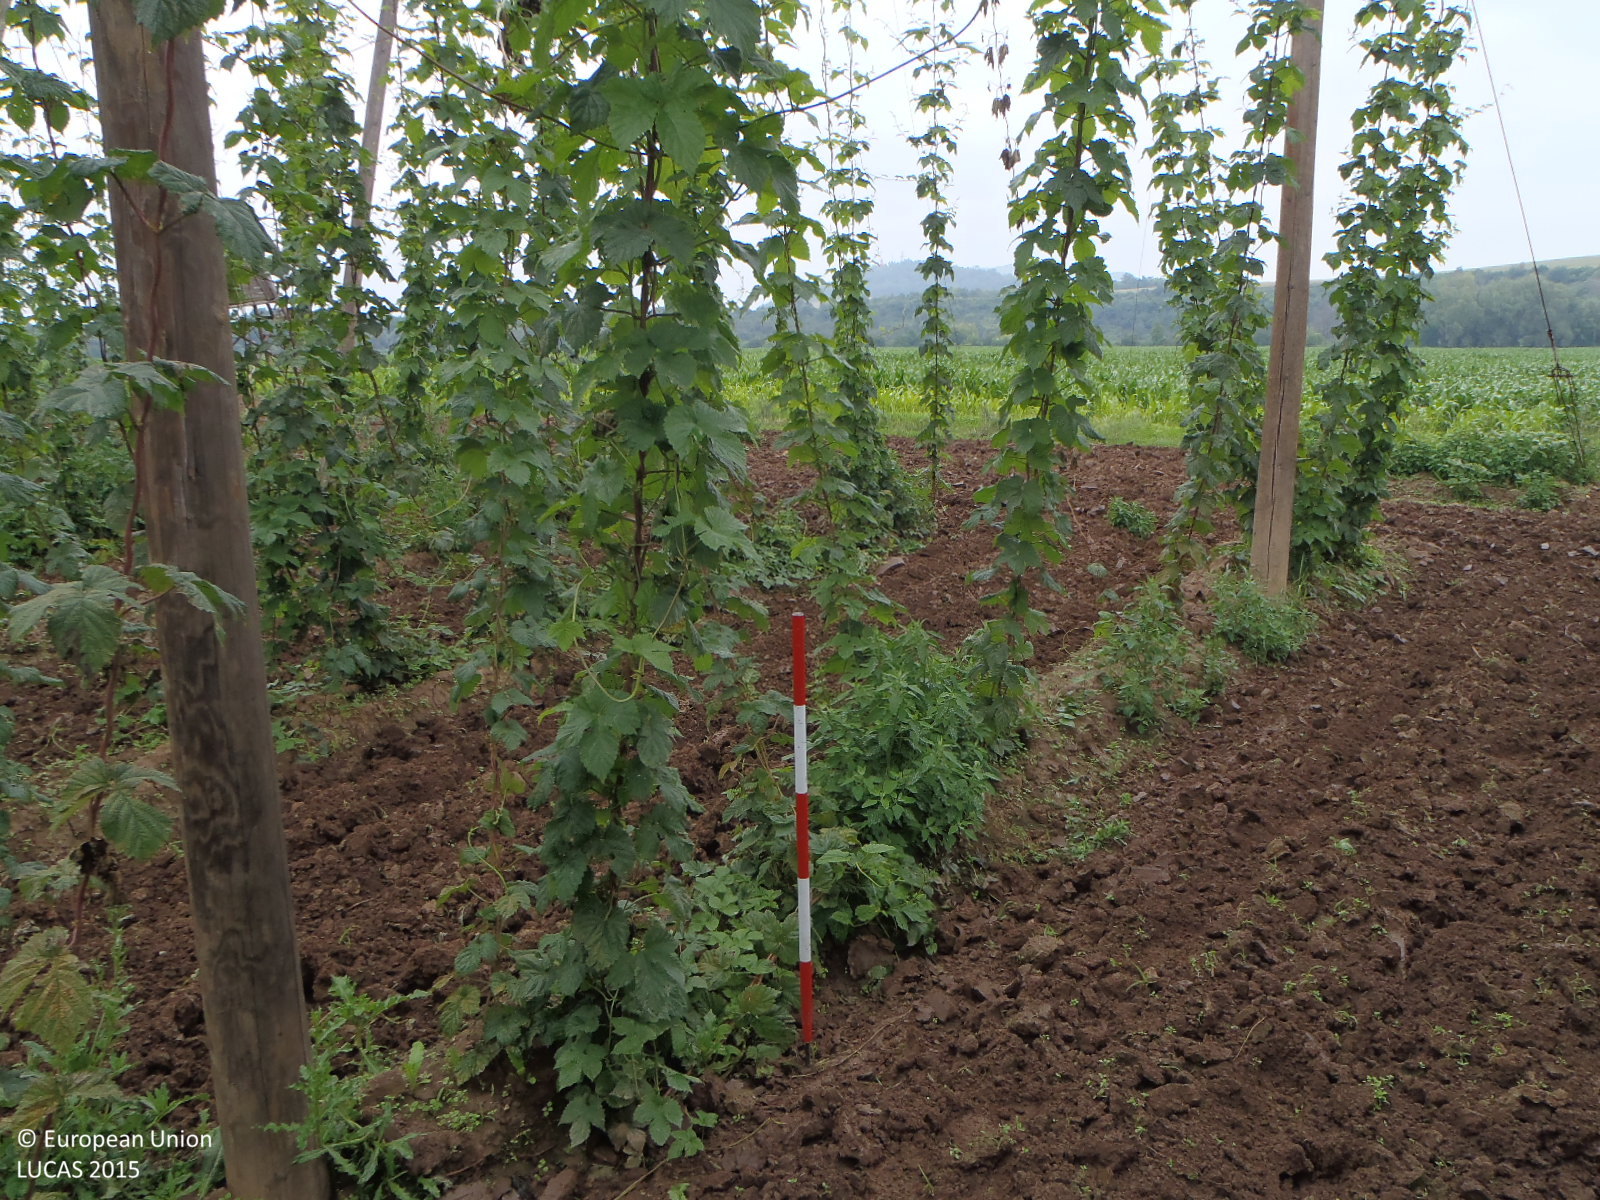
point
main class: Cropland
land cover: Other non-permanent industrial crops
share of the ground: 50 - 75 %
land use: Agriculture (excluding fallow land and kitchen gardens)
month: June
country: CZ
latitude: 50.3726
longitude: 13.8111
